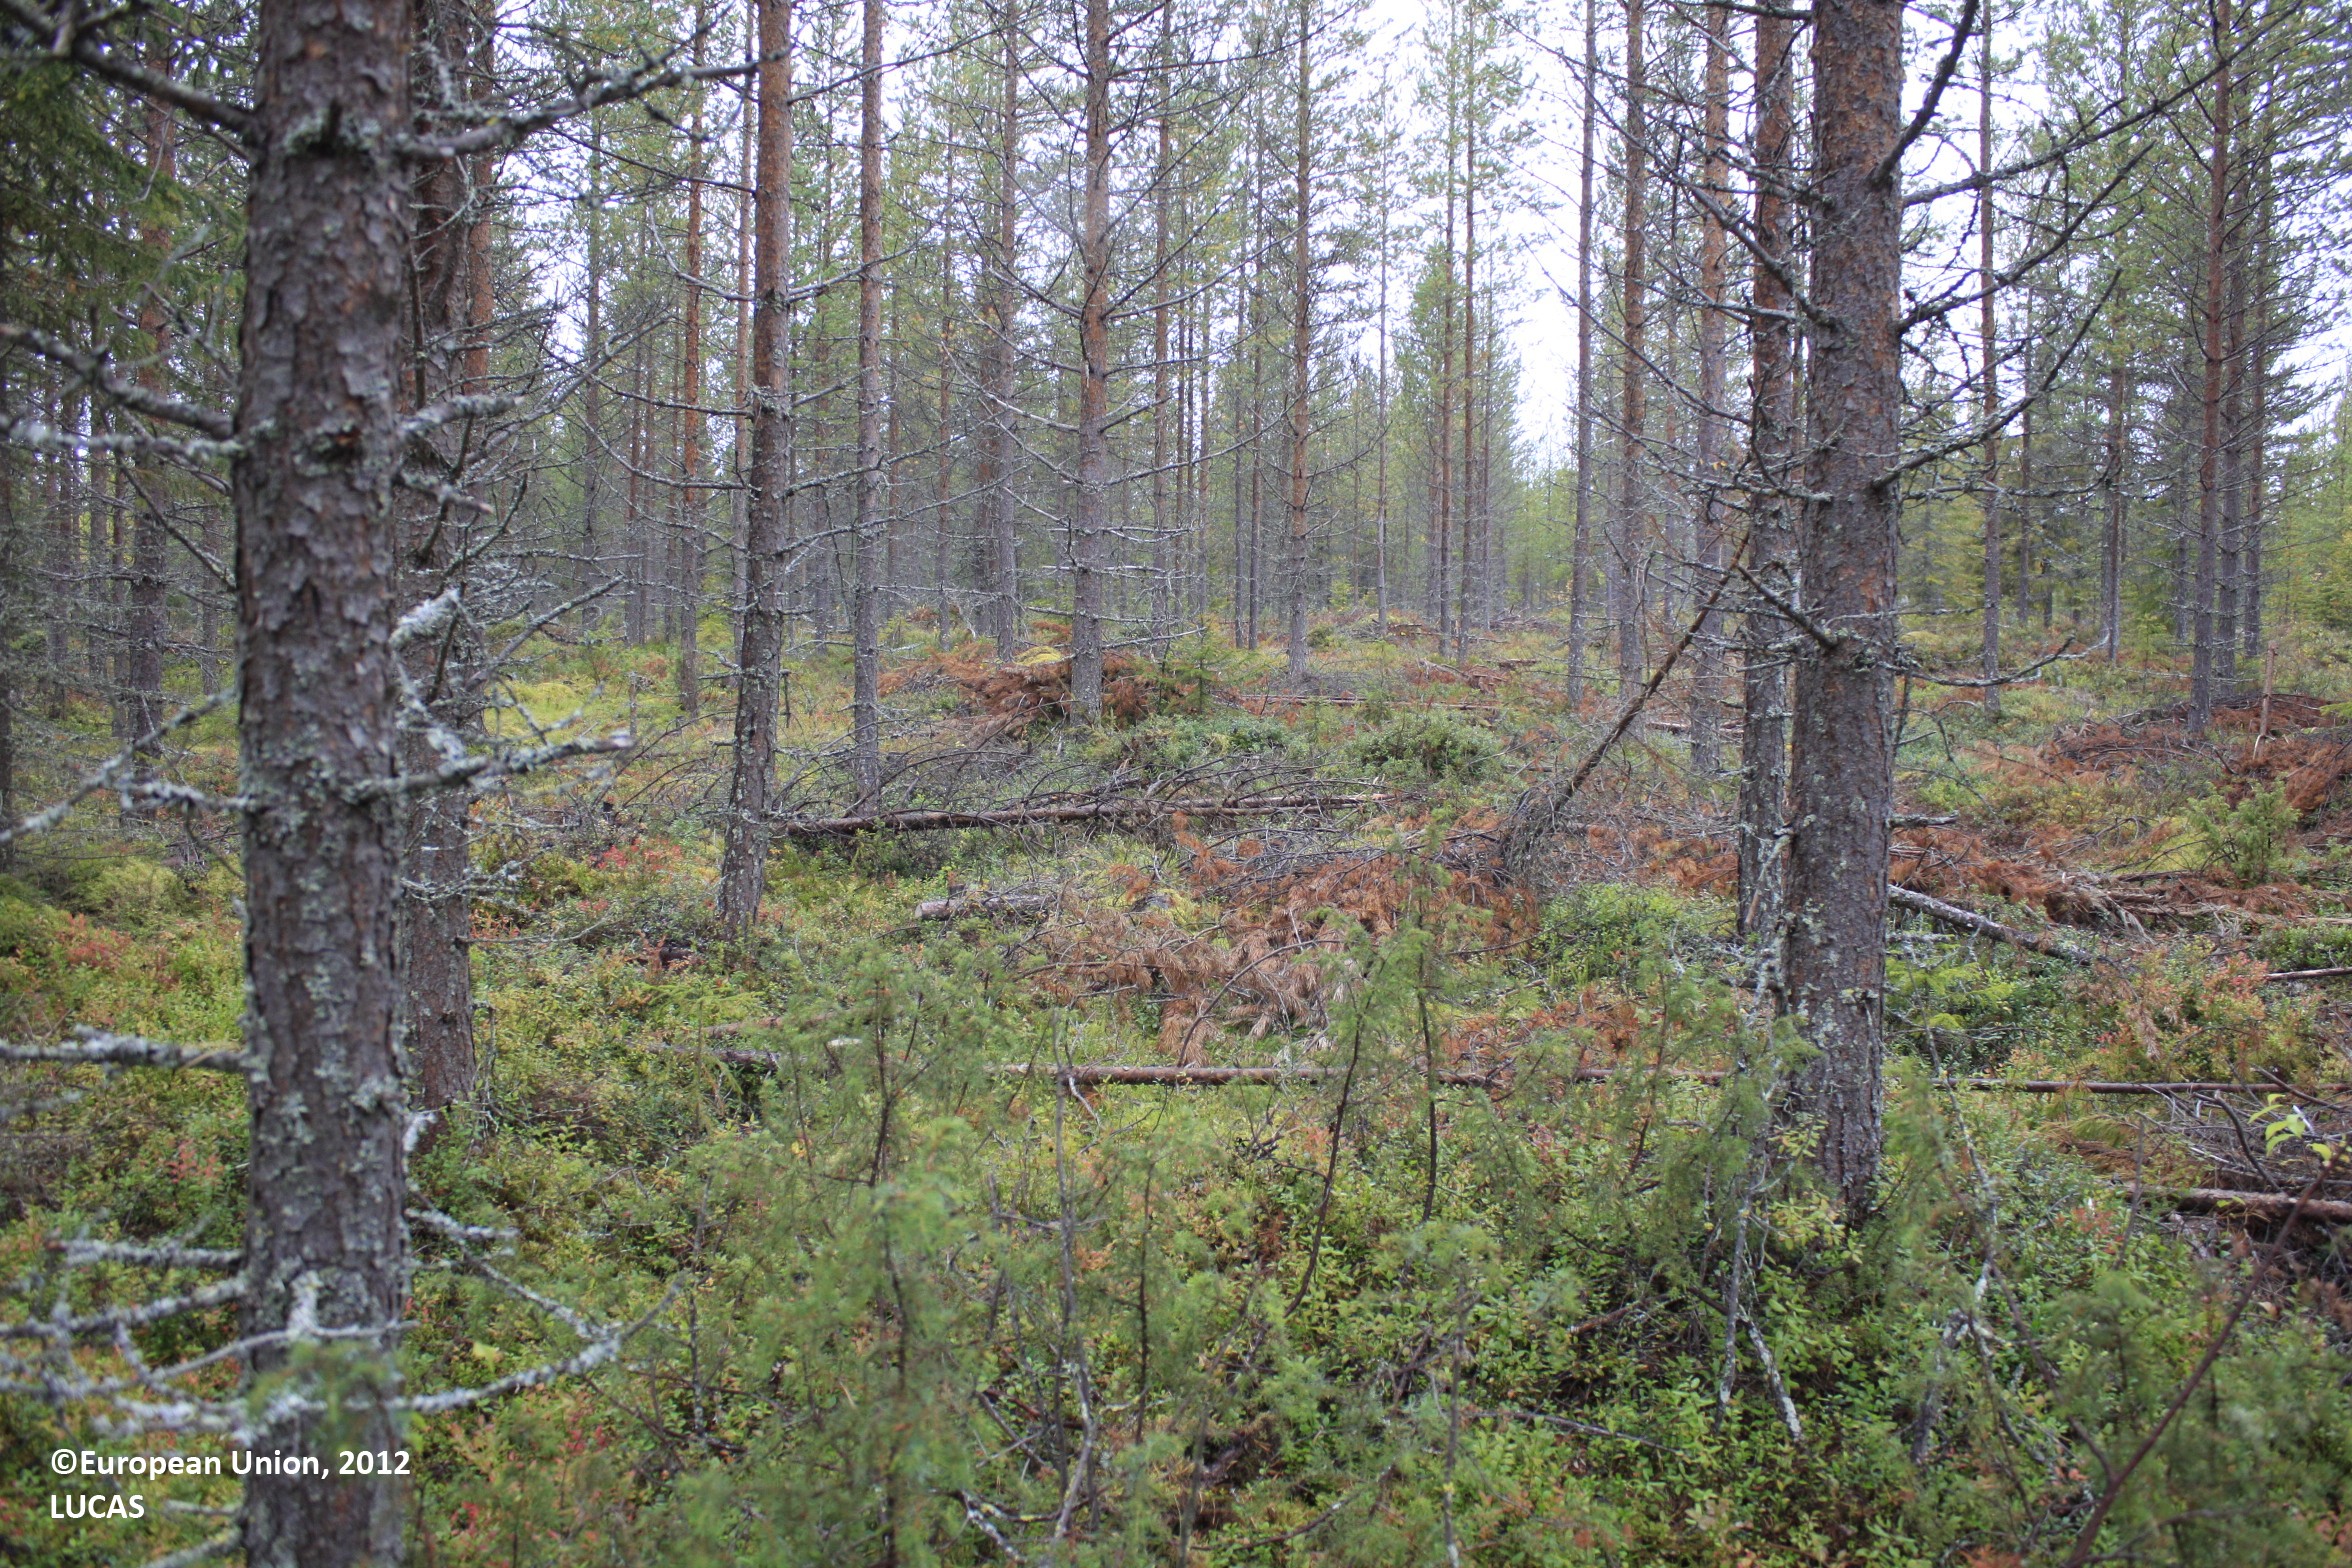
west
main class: Woodland
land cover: Pine dominated coniferous woodland
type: boreal forest
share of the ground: 25 - 50 %
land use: Forestry
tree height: > 5 m
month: September
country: FI
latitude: 65.8503
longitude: 27.1788
